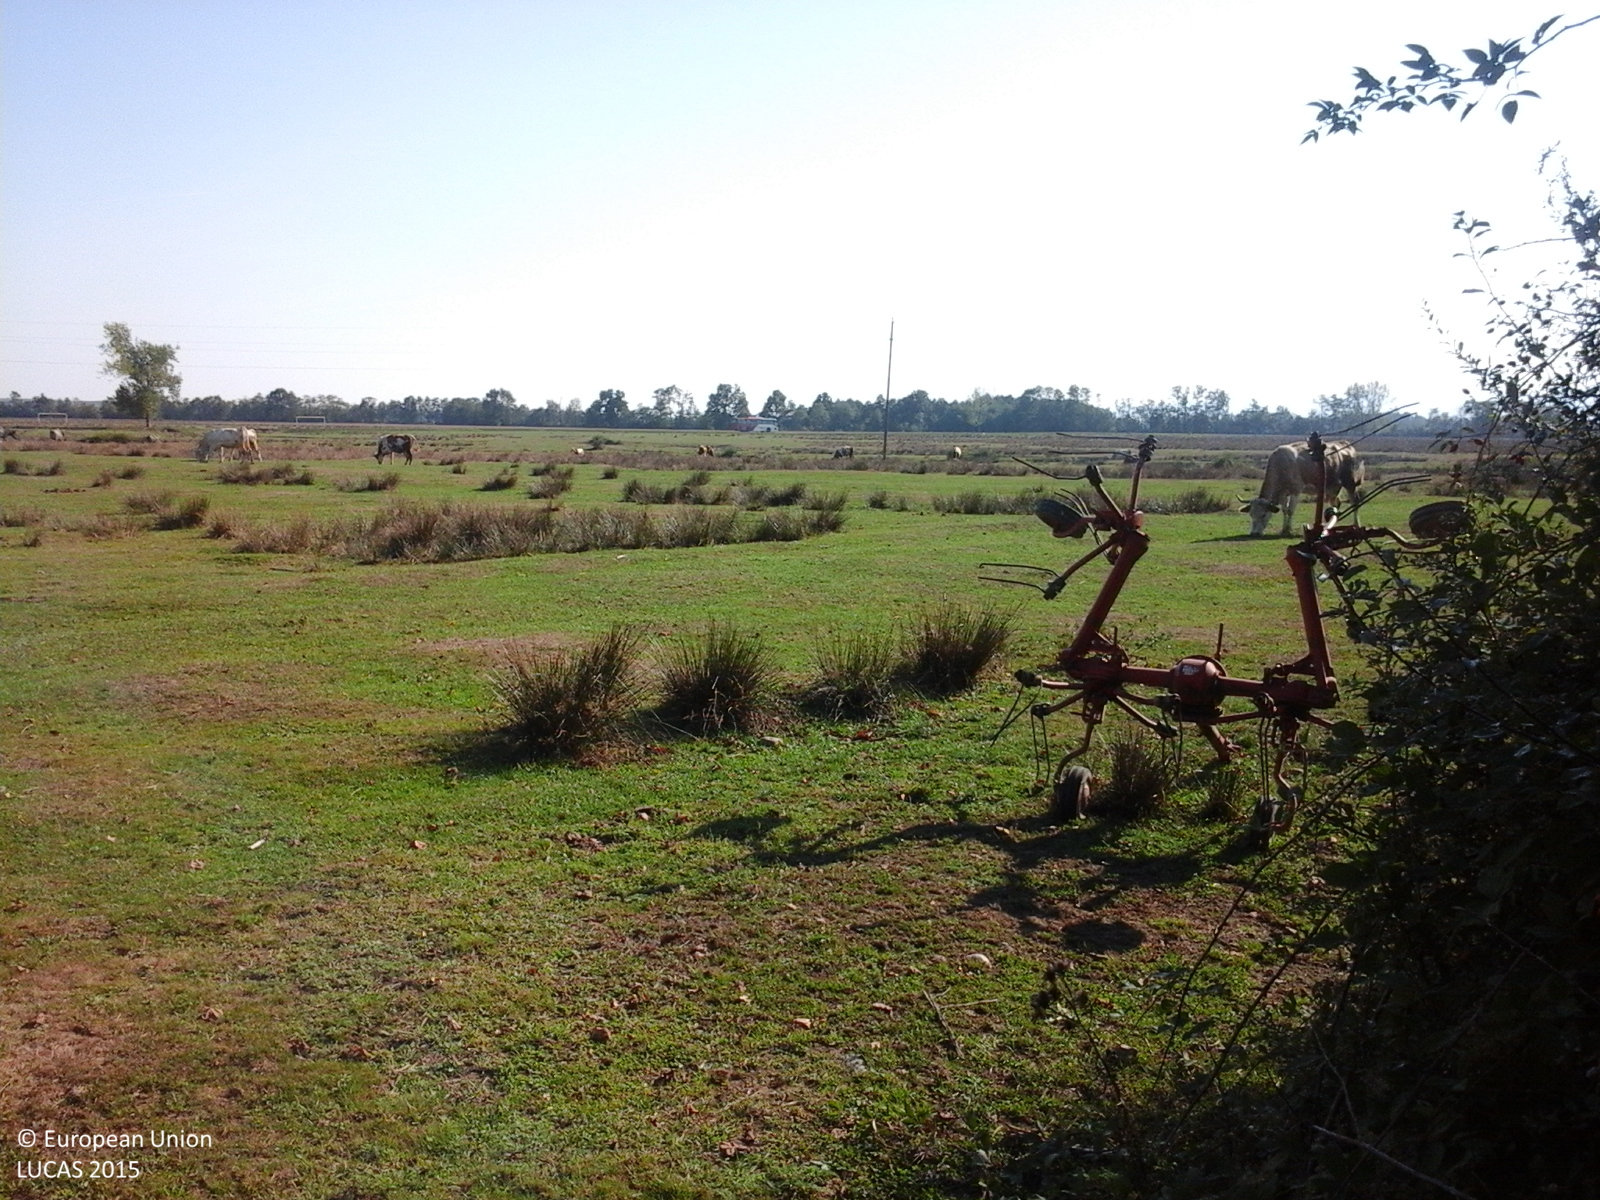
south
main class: Grassland
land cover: Grassland without tree/shrub cover
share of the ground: > 75 %
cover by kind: herbaceous plants 100 %
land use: Agriculture (excluding fallow land and kitchen gardens)
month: September
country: RO
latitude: 46.7115
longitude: 22.4660
